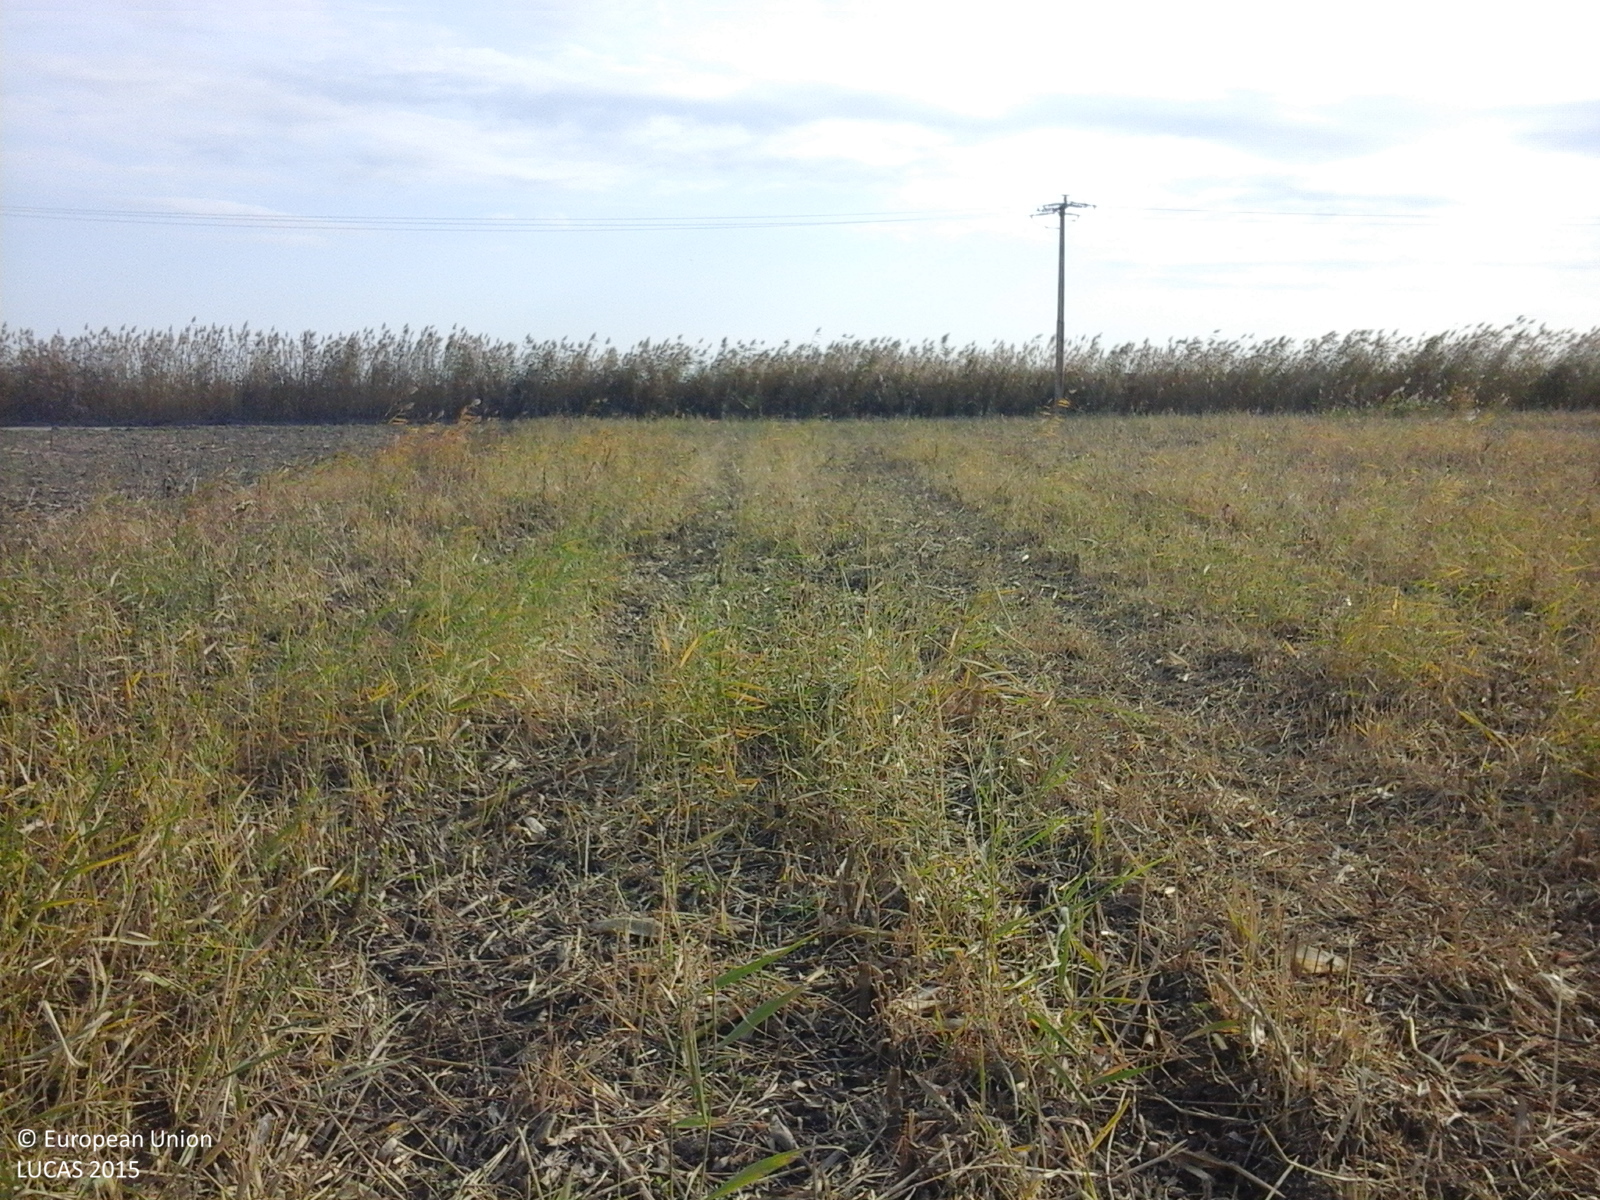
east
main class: Cropland
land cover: Maize
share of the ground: < 10 %
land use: Agriculture (excluding fallow land and kitchen gardens)
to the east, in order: Maize; Tracks; Spontaneously vegetated surfaces; Electric lines; Spontaneously vegetated surfaces; Ditches and canals; Spontaneously vegetated surfaces; Tracks; Maize
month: October
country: RO
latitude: 45.1257
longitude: 27.2160
